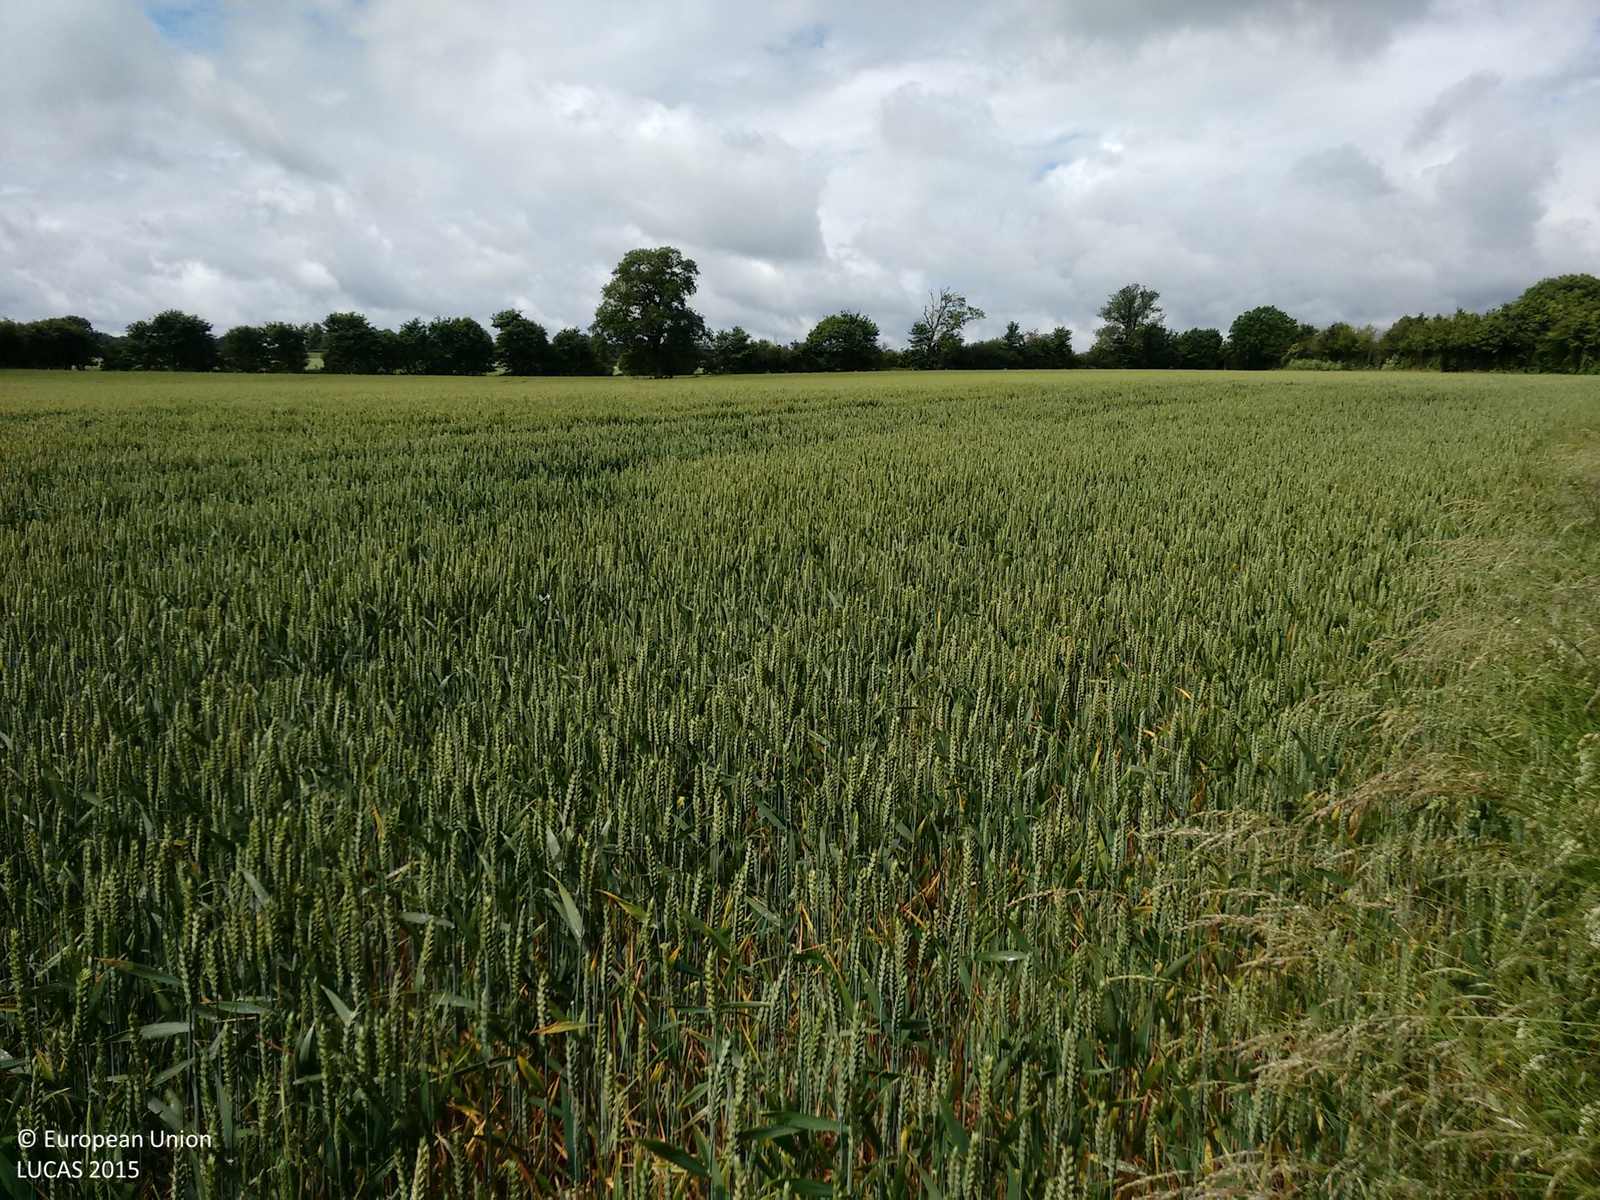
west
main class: Cropland
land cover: Common wheat
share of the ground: > 75 %
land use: Agriculture (excluding fallow land and kitchen gardens)
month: June
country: GB
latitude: 51.2985
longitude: -2.2970
